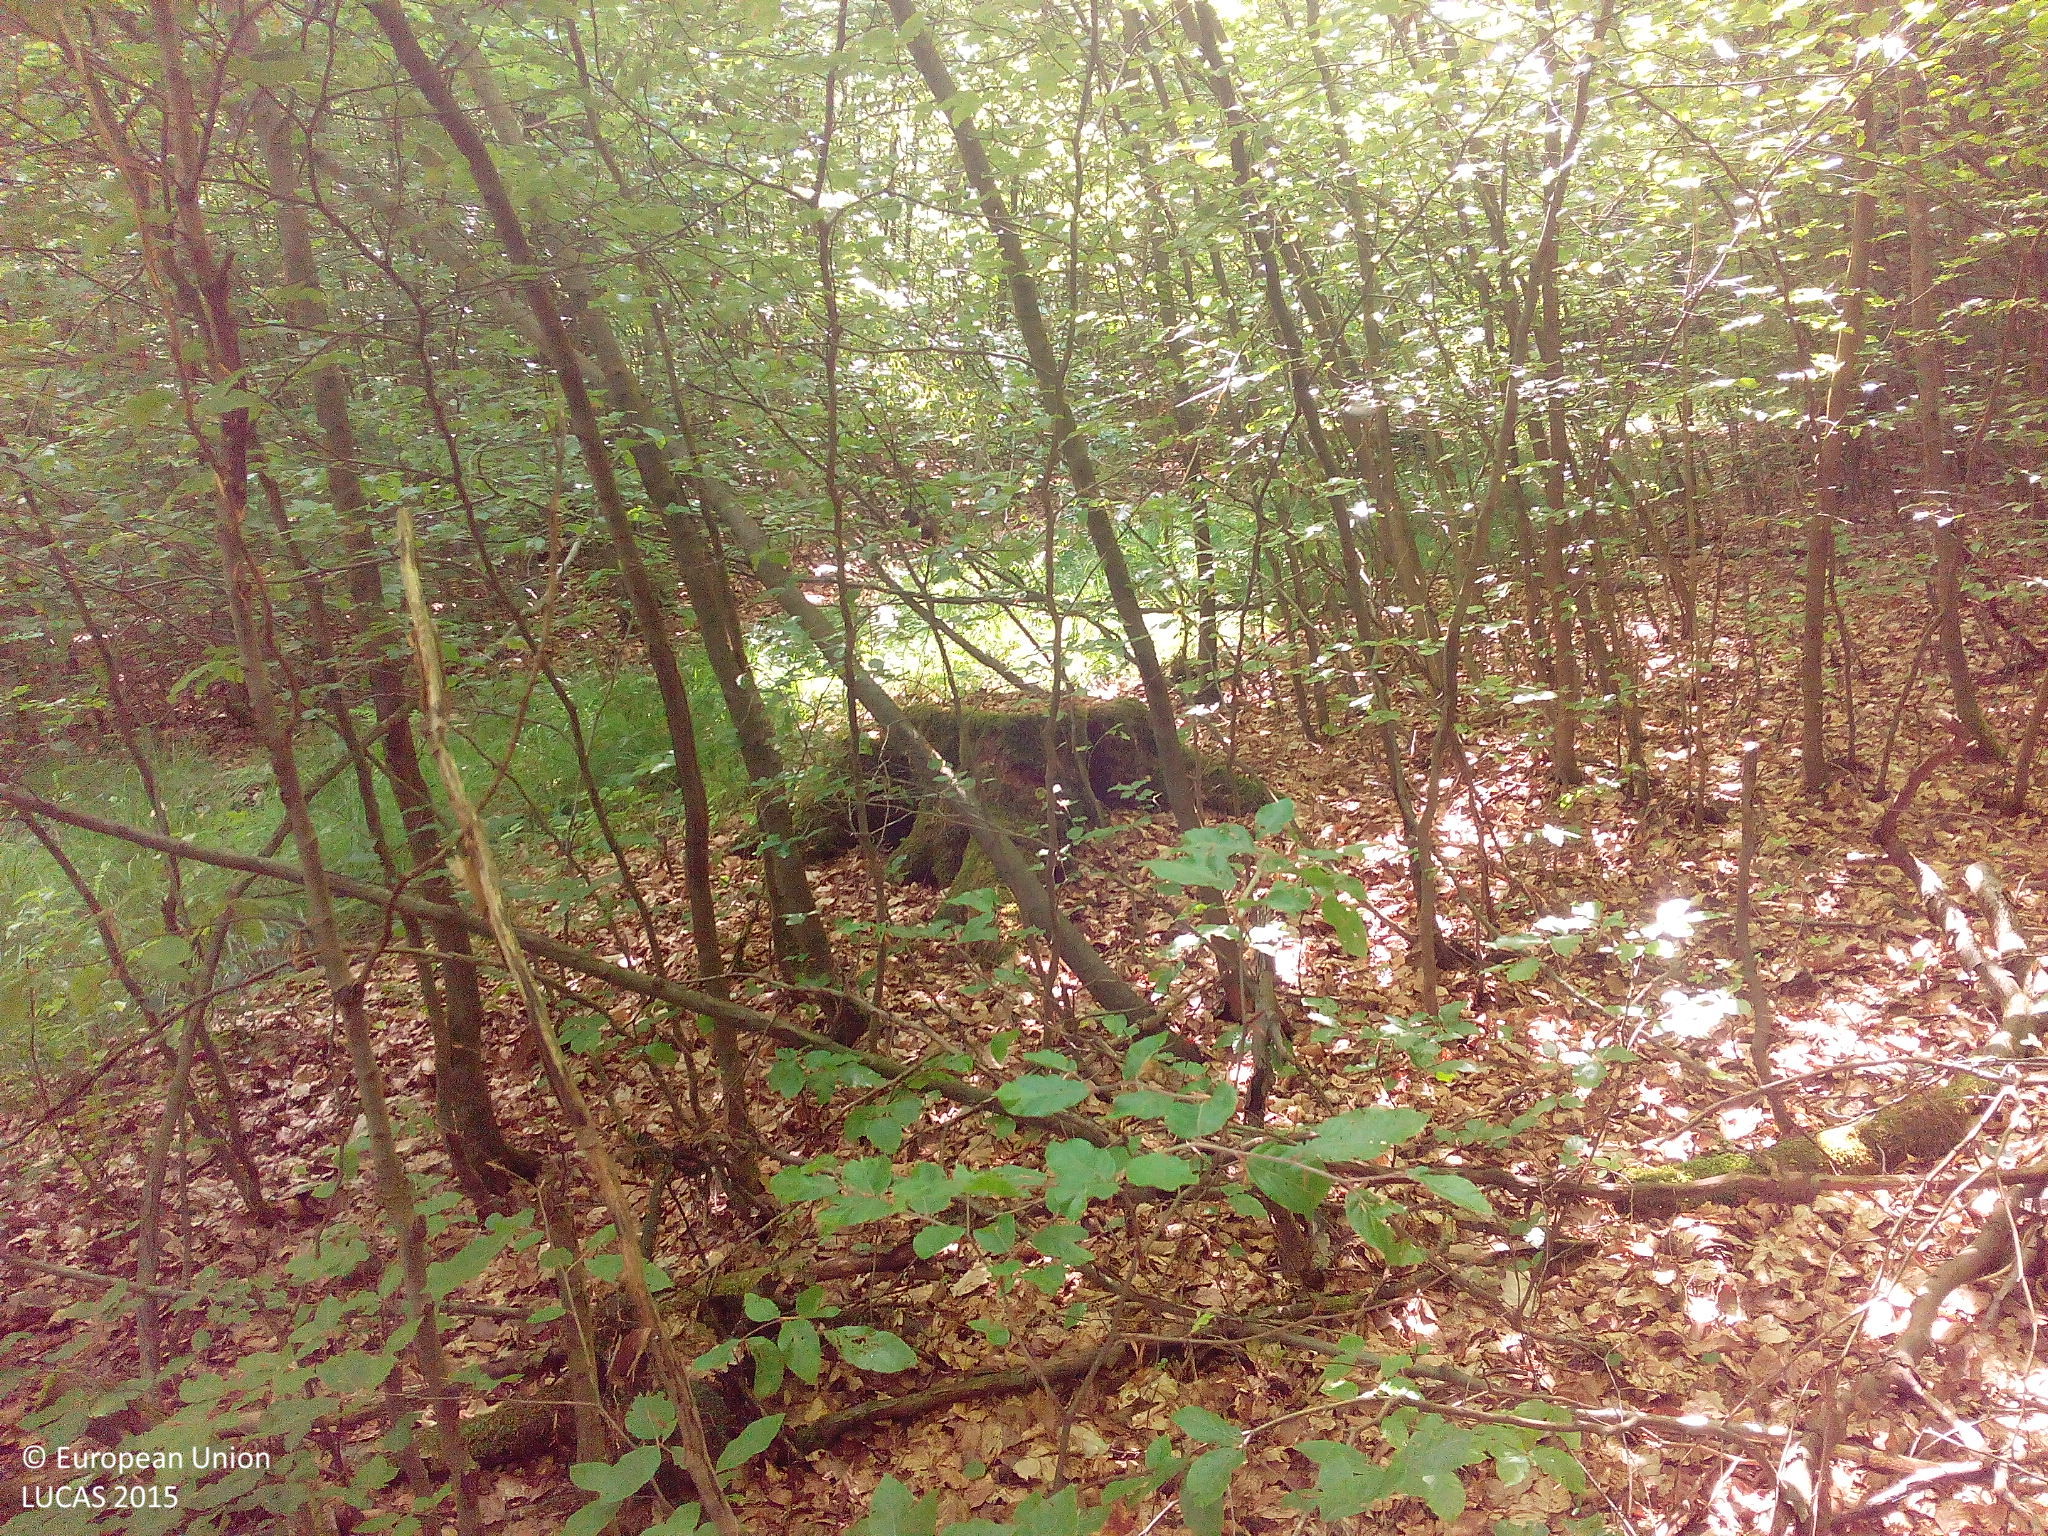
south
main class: Woodland
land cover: Broadleaved woodland
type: beech forest
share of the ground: > 75 %
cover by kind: broadleaved forest trees 95 %, unconsolidated bare surface 5 %
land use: Forestry
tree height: > 5 m
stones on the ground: < 10 %
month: May
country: DE
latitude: 51.2265
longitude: 9.6421
